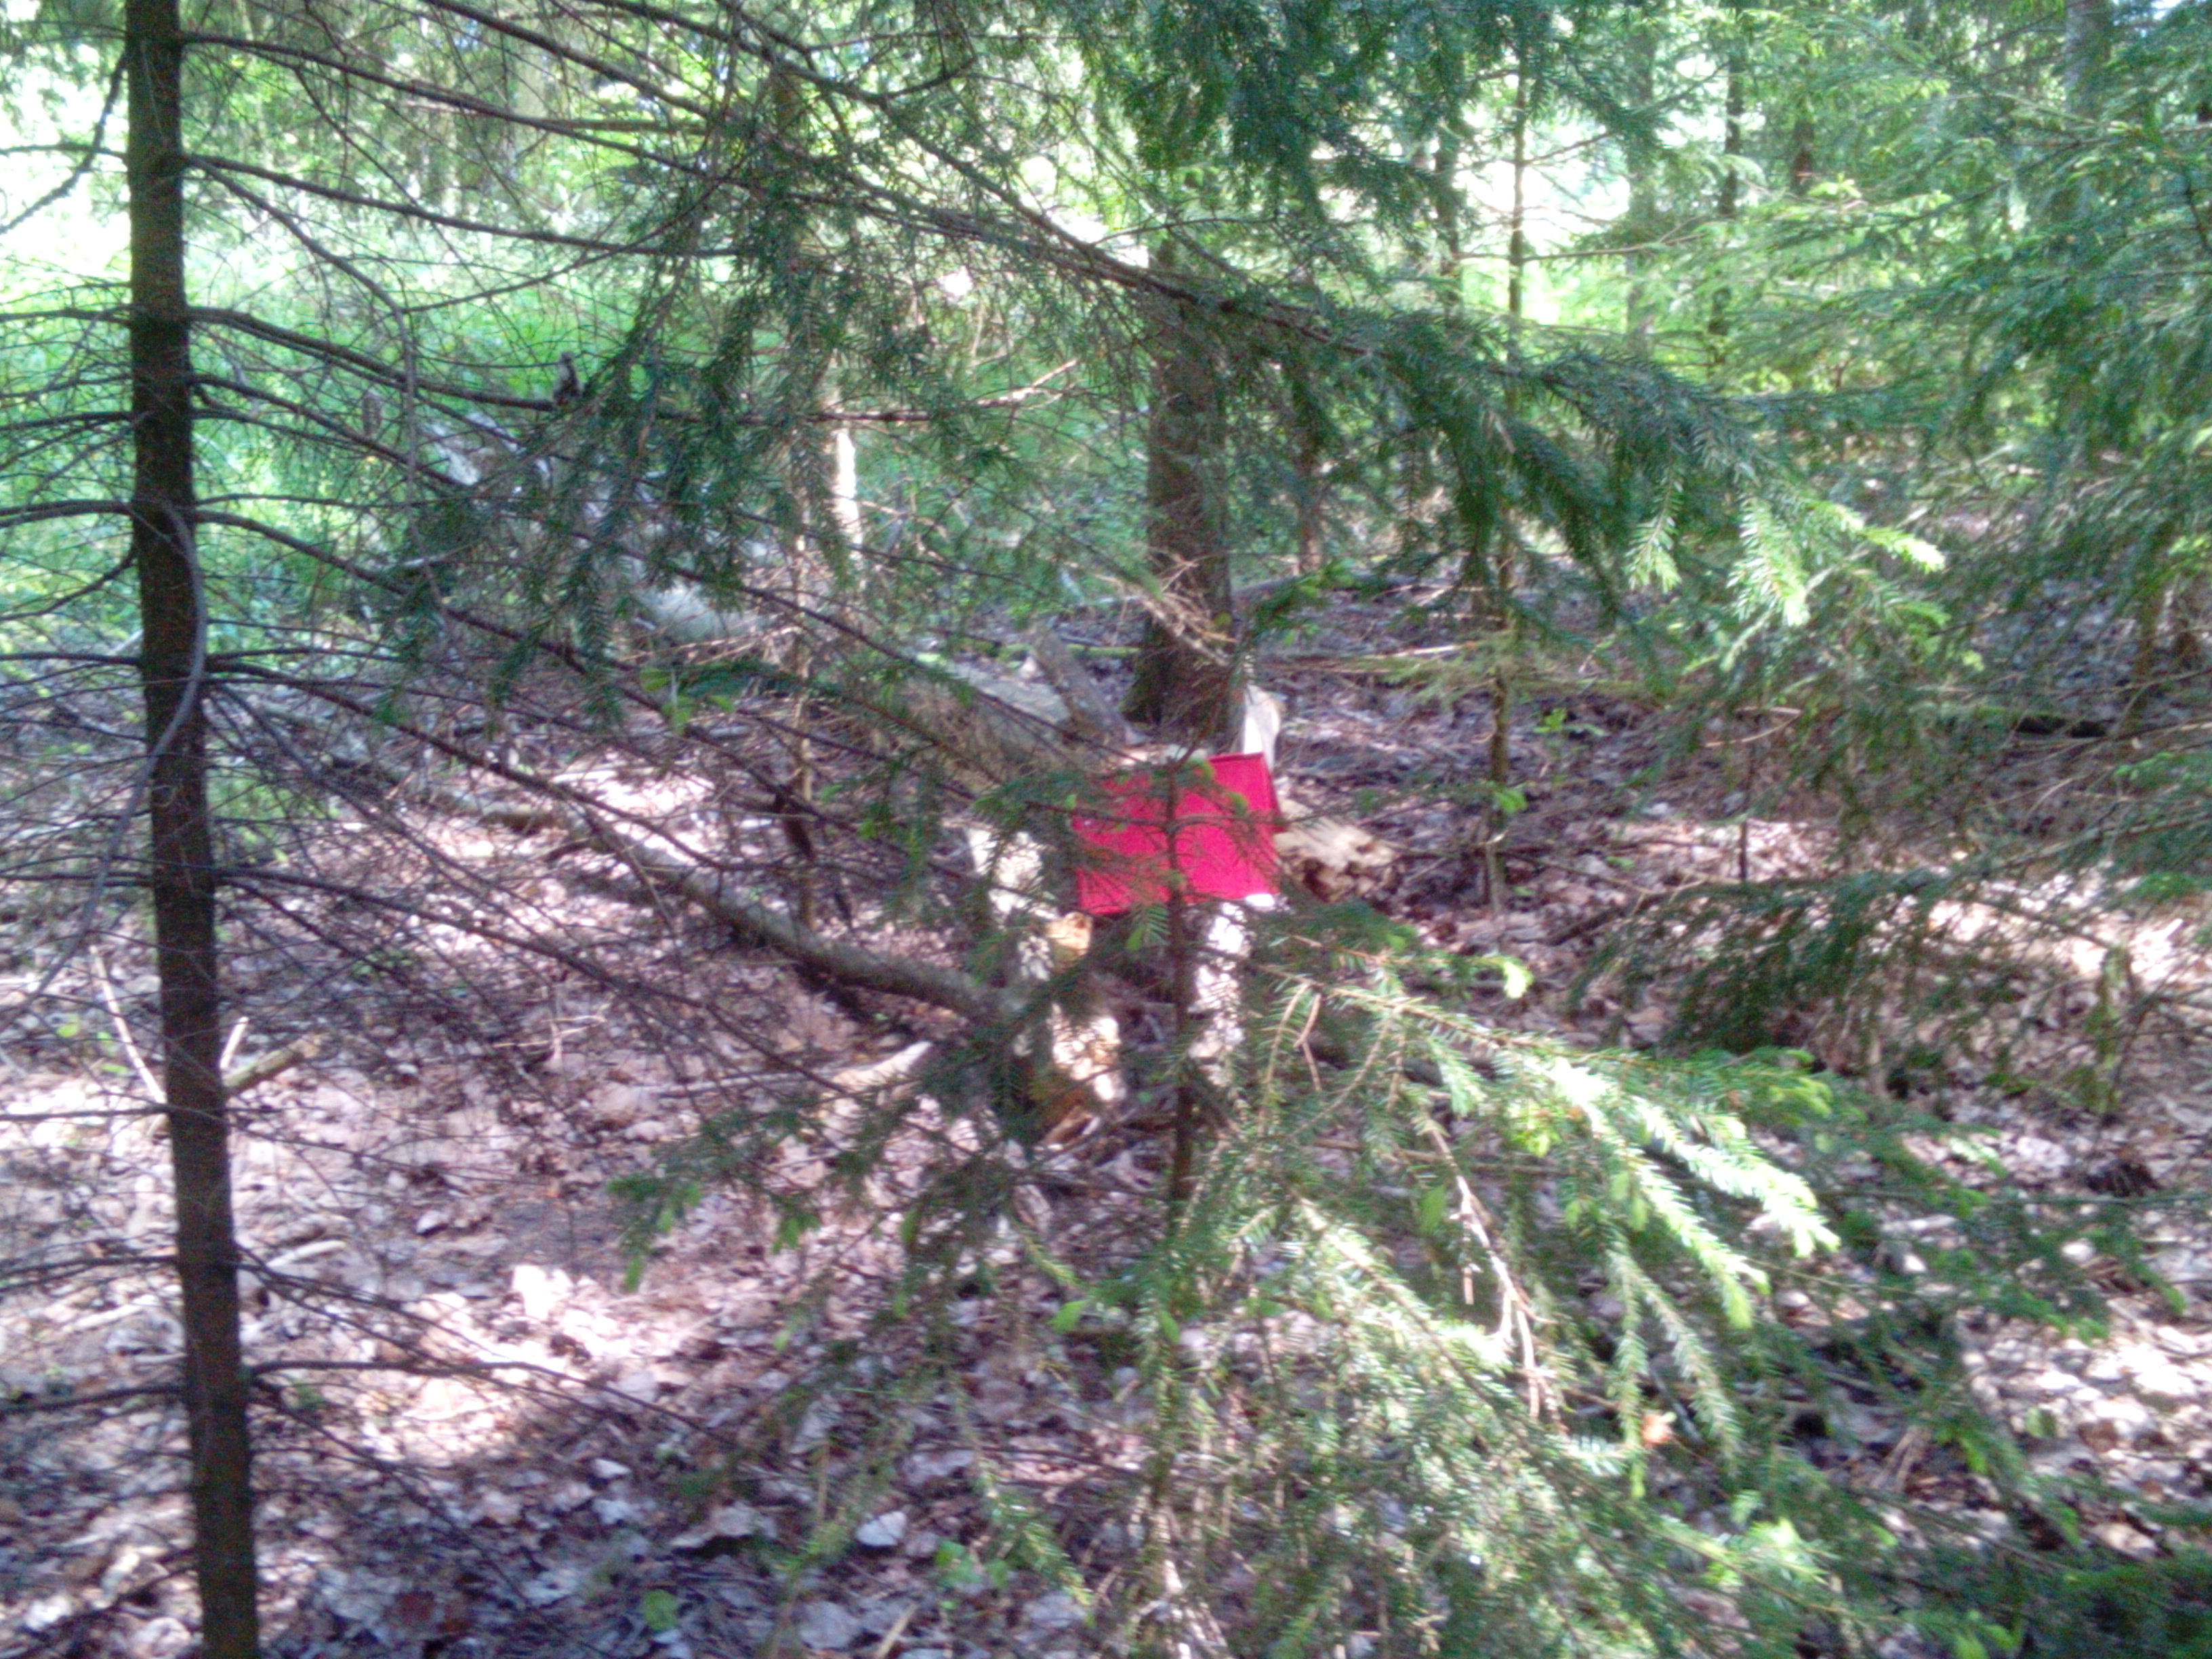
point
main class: Woodland
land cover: Spruce dominated mixed woodland
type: hemiboreal forest and nemoral coniferous forest and mixed broadleaved-coniferous forest
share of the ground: > 75 %
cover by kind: broadleaved forest trees 50 %, coniferous forest trees 40 %, herbaceous plants 10 %
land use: Forestry
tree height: > 5 m
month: June
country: LV
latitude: 56.6733
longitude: 22.2433
